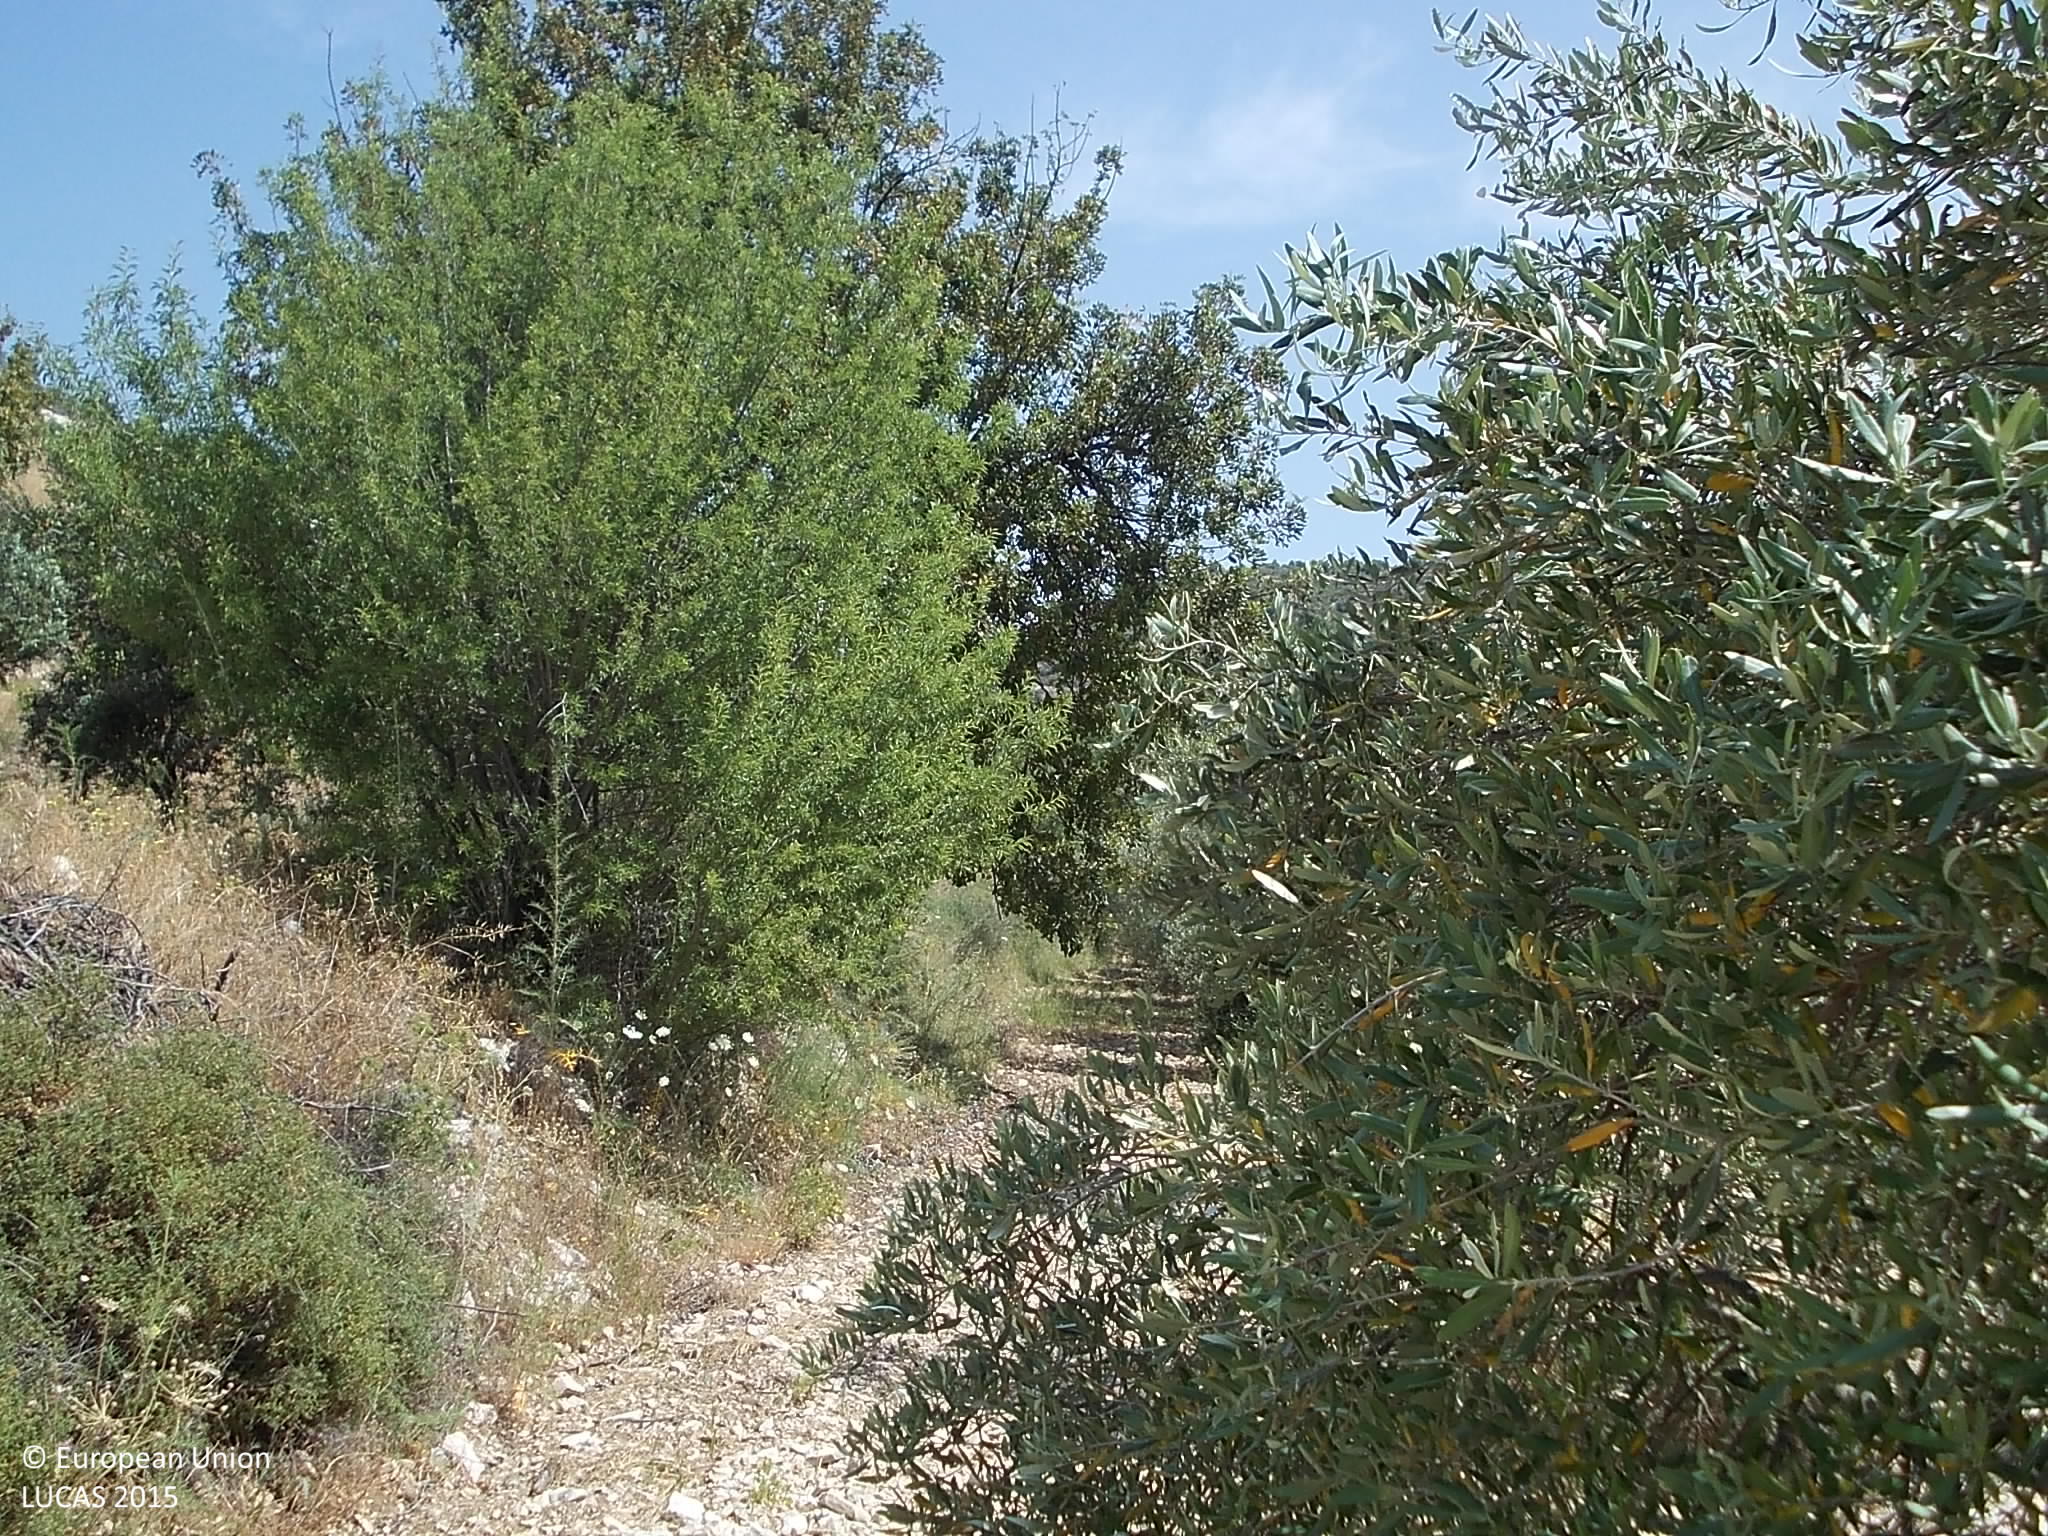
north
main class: Cropland
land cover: Olive groves
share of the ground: 25 - 50 %
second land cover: Rocks and stones
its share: > 75 %
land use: Agriculture (excluding fallow land and kitchen gardens)
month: May
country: CY
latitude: 34.7943
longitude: 32.9986
